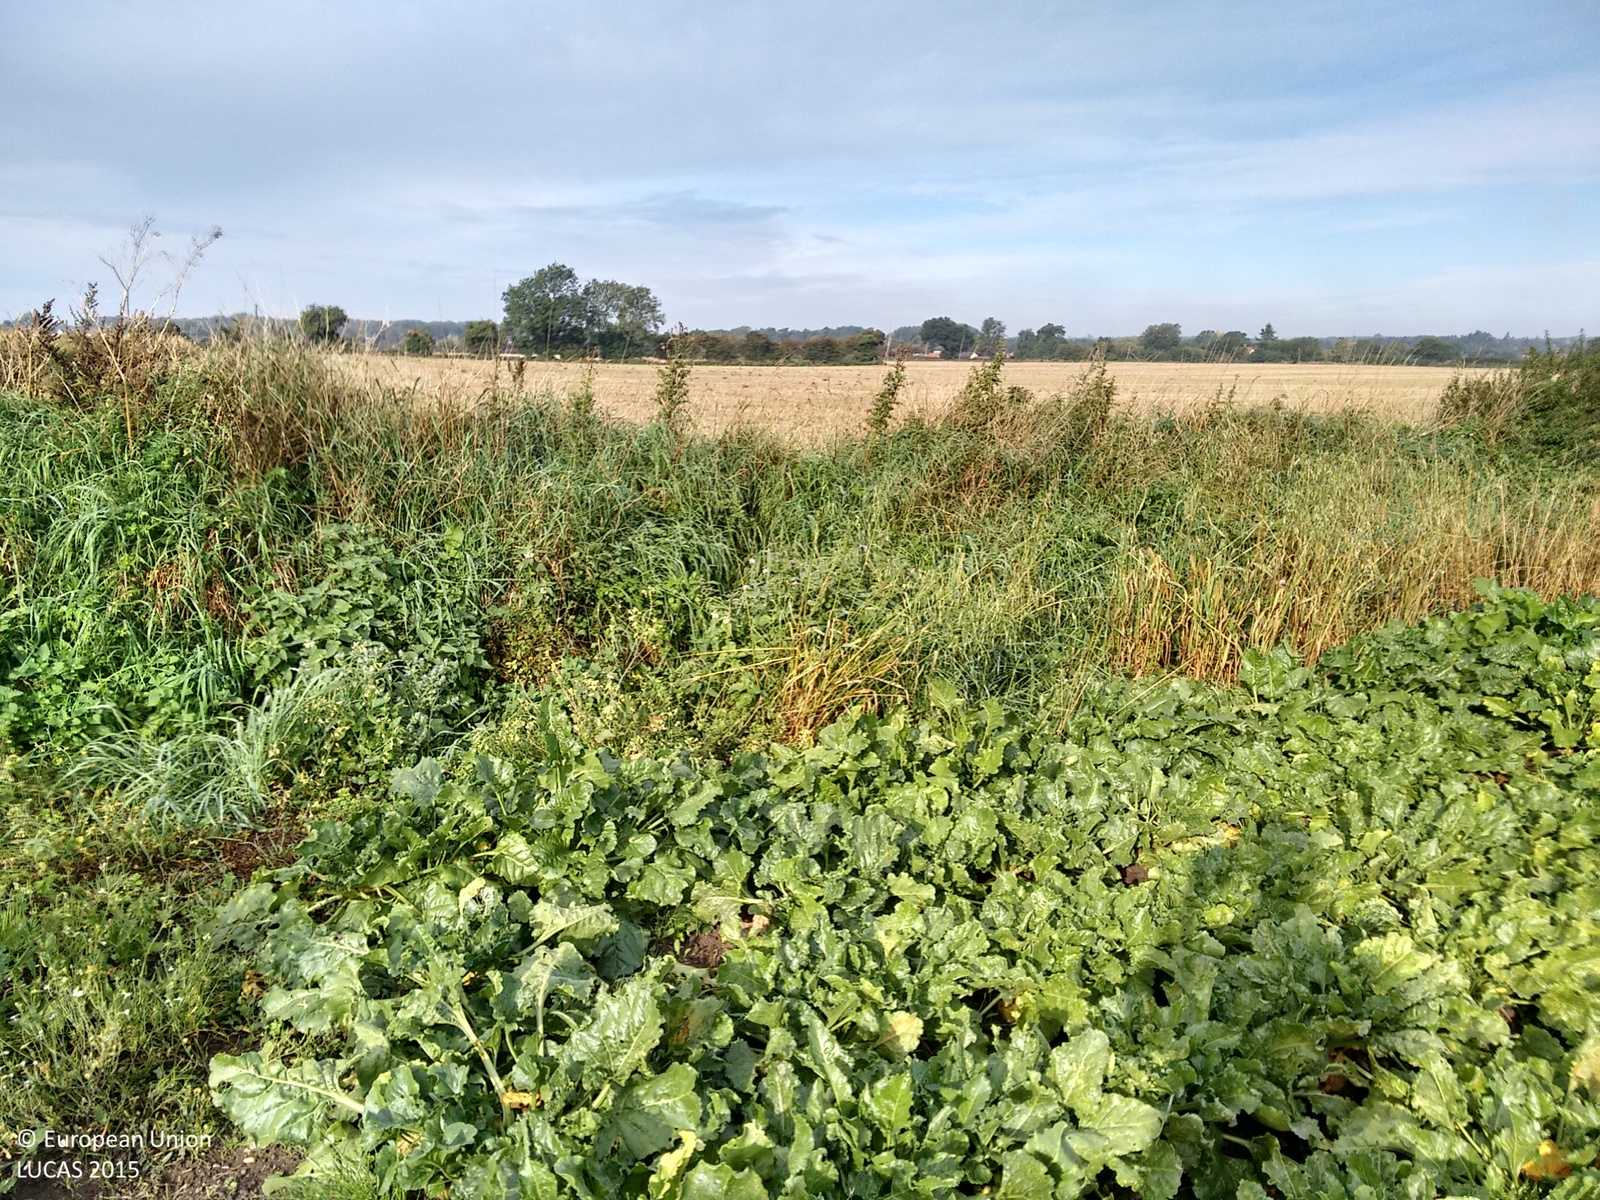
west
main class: Cropland
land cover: Sugar beet
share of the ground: > 75 %
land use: Agriculture (excluding fallow land and kitchen gardens)
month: September
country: GB
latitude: 52.6902
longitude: 1.2949
